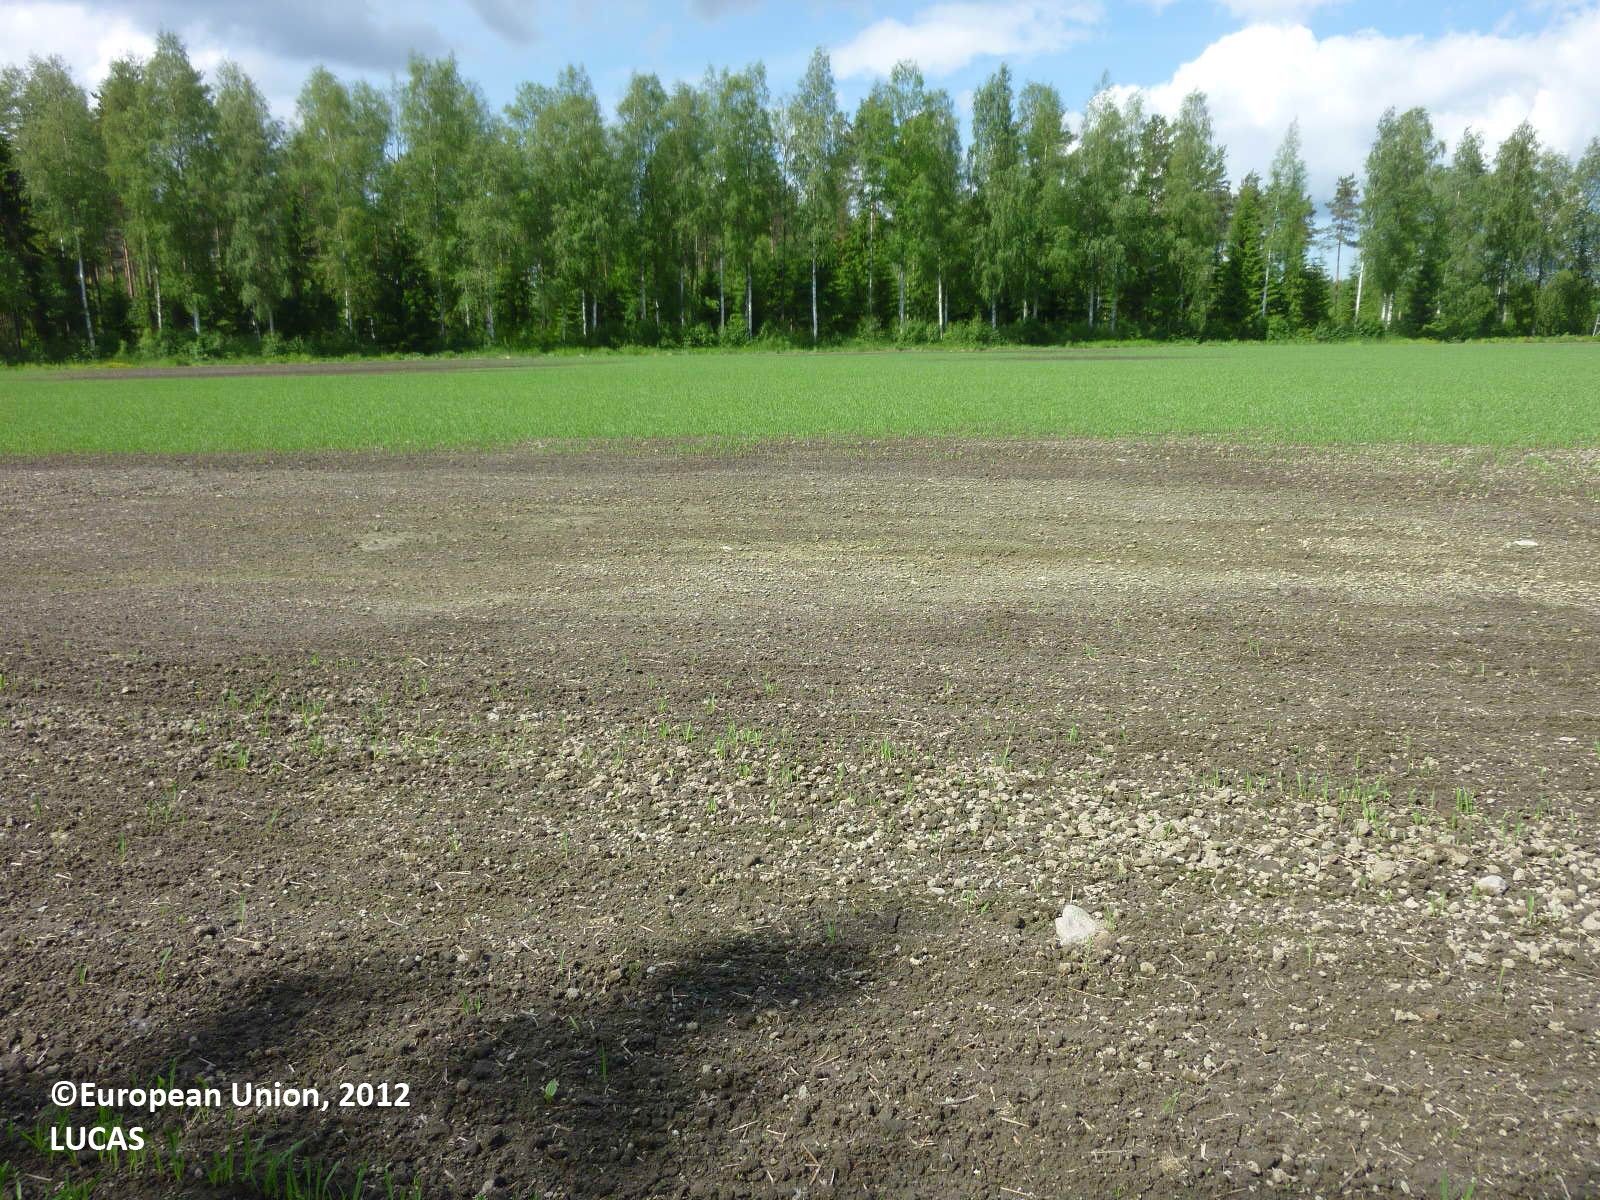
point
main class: Cropland
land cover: Oats
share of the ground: 25 - 50 %
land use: Agriculture (excluding fallow land and kitchen gardens)
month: June
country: FI
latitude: 61.3928
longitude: 22.5148
